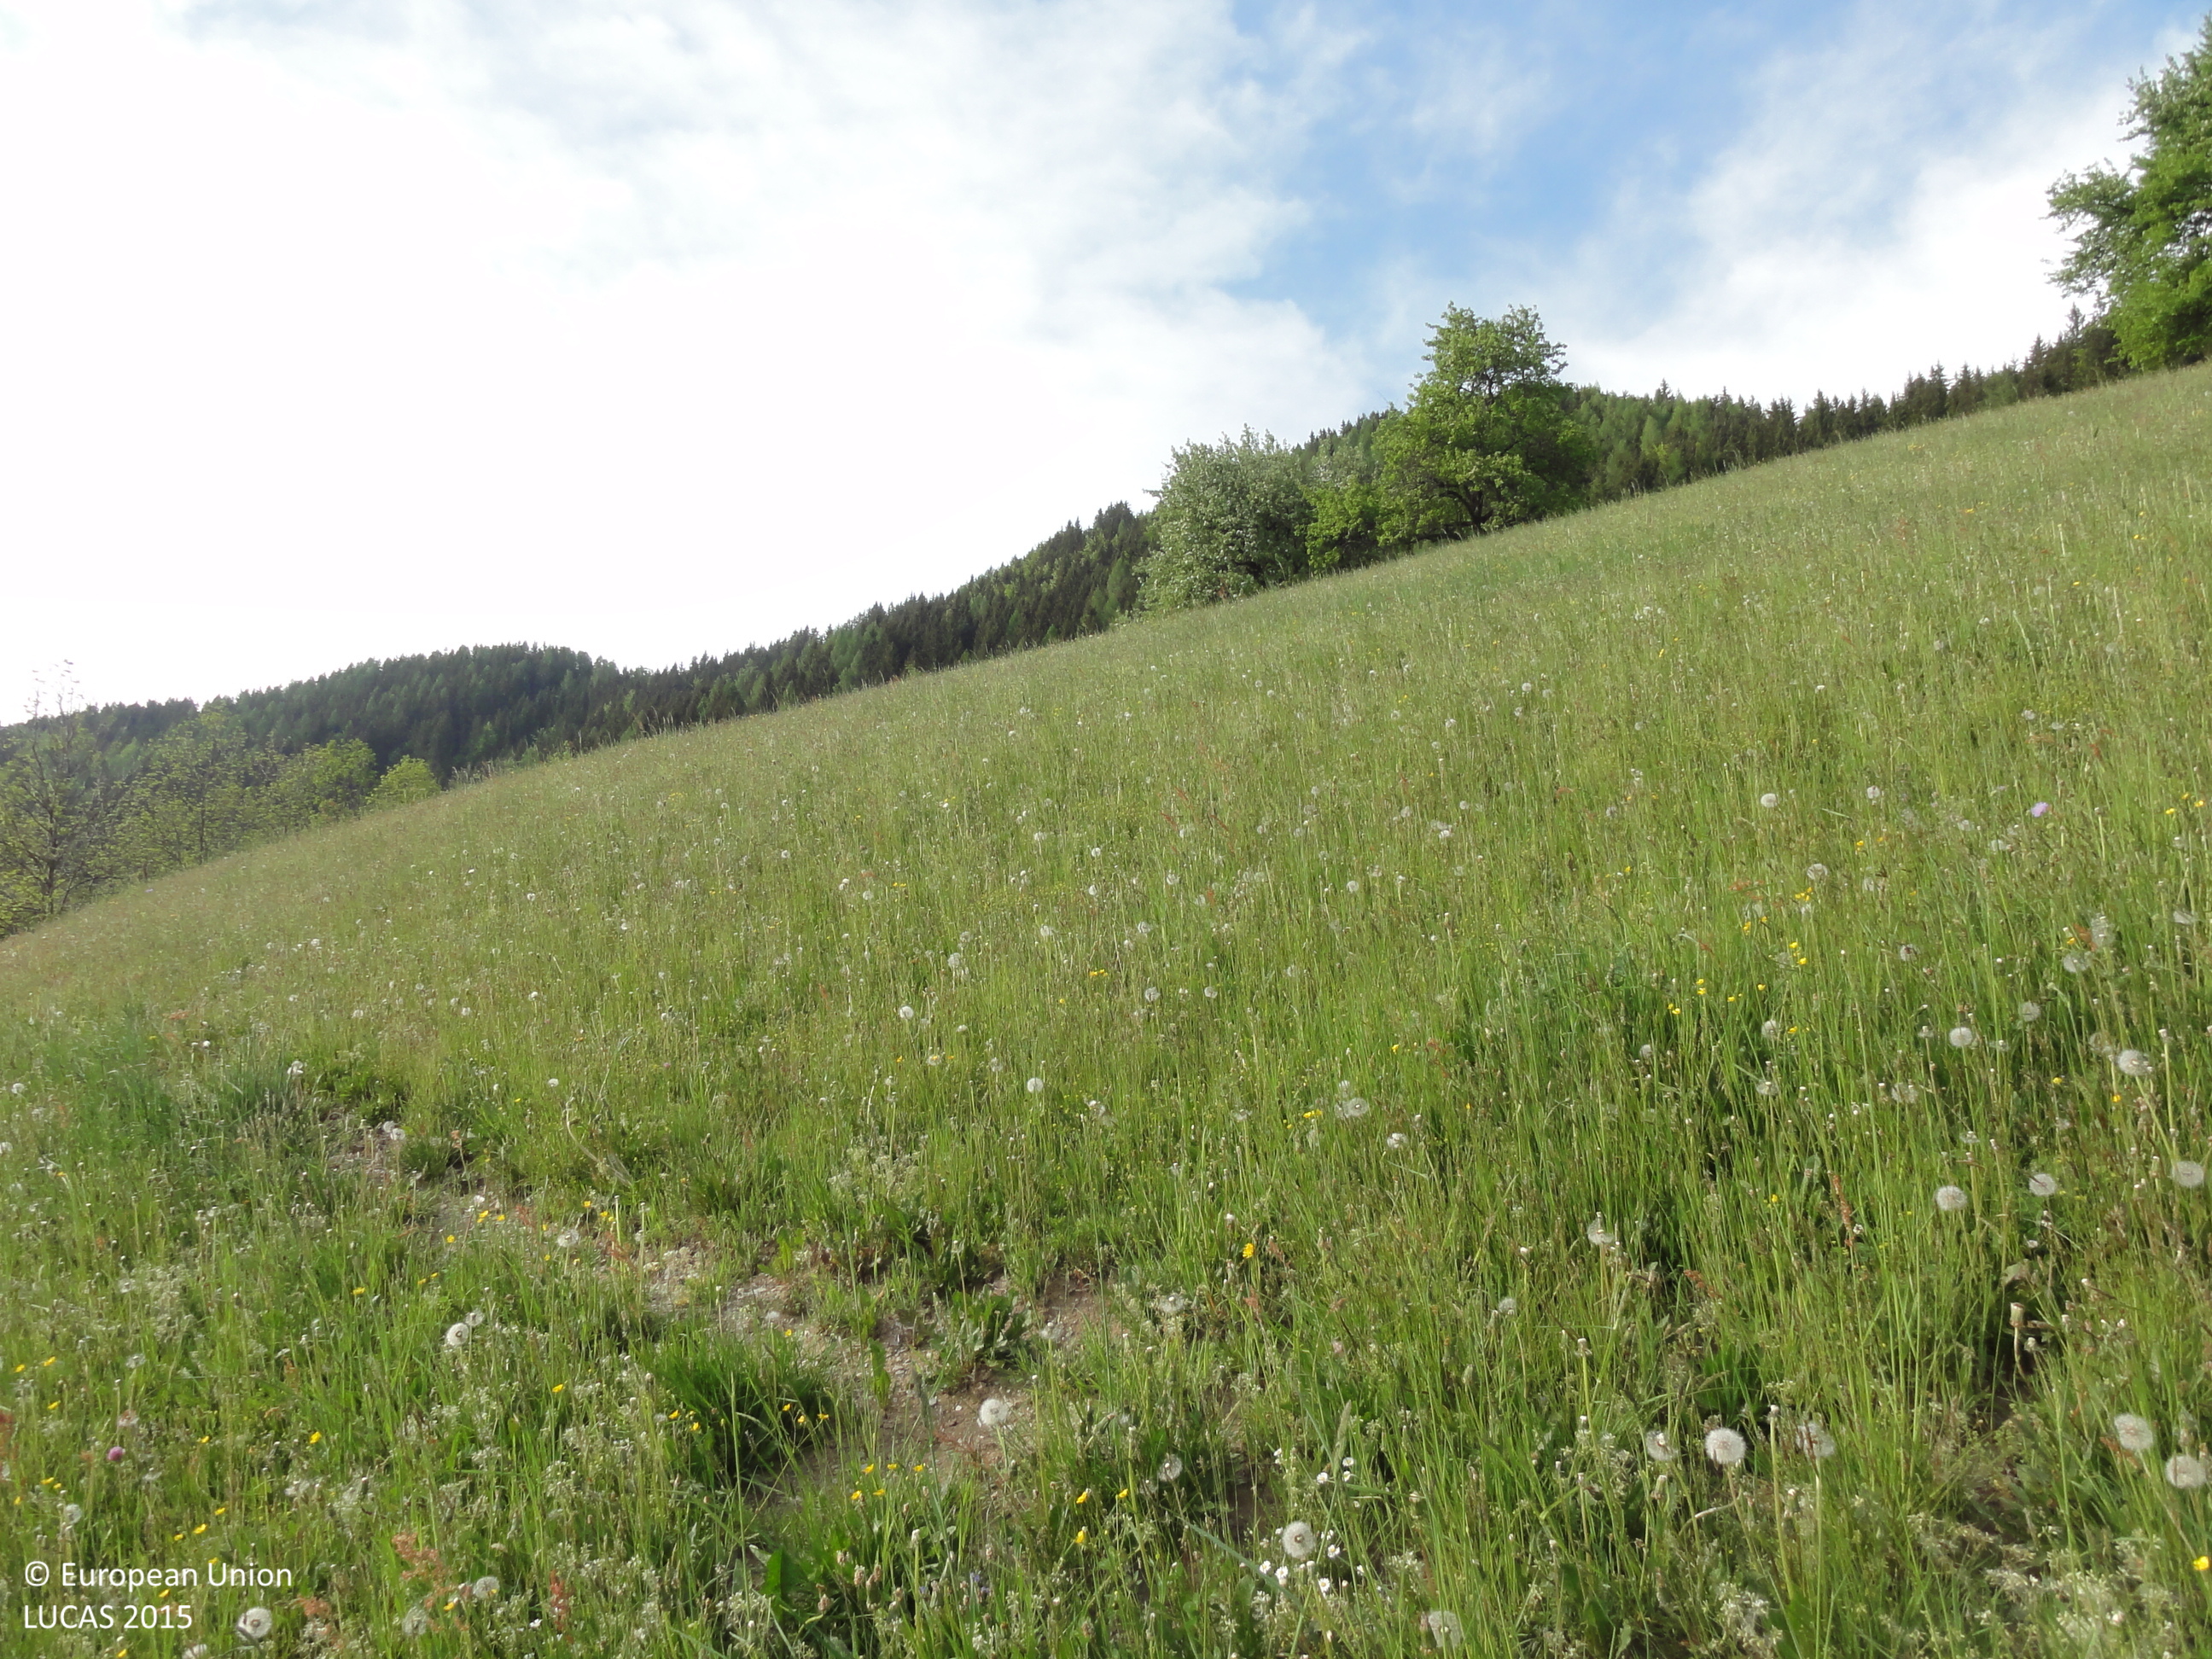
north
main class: Grassland
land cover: Grassland without tree/shrub cover
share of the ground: > 75 %
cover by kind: herbaceous plants 100 %
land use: Agriculture (excluding fallow land and kitchen gardens)
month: May
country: SI
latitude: 46.4552
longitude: 14.9061
